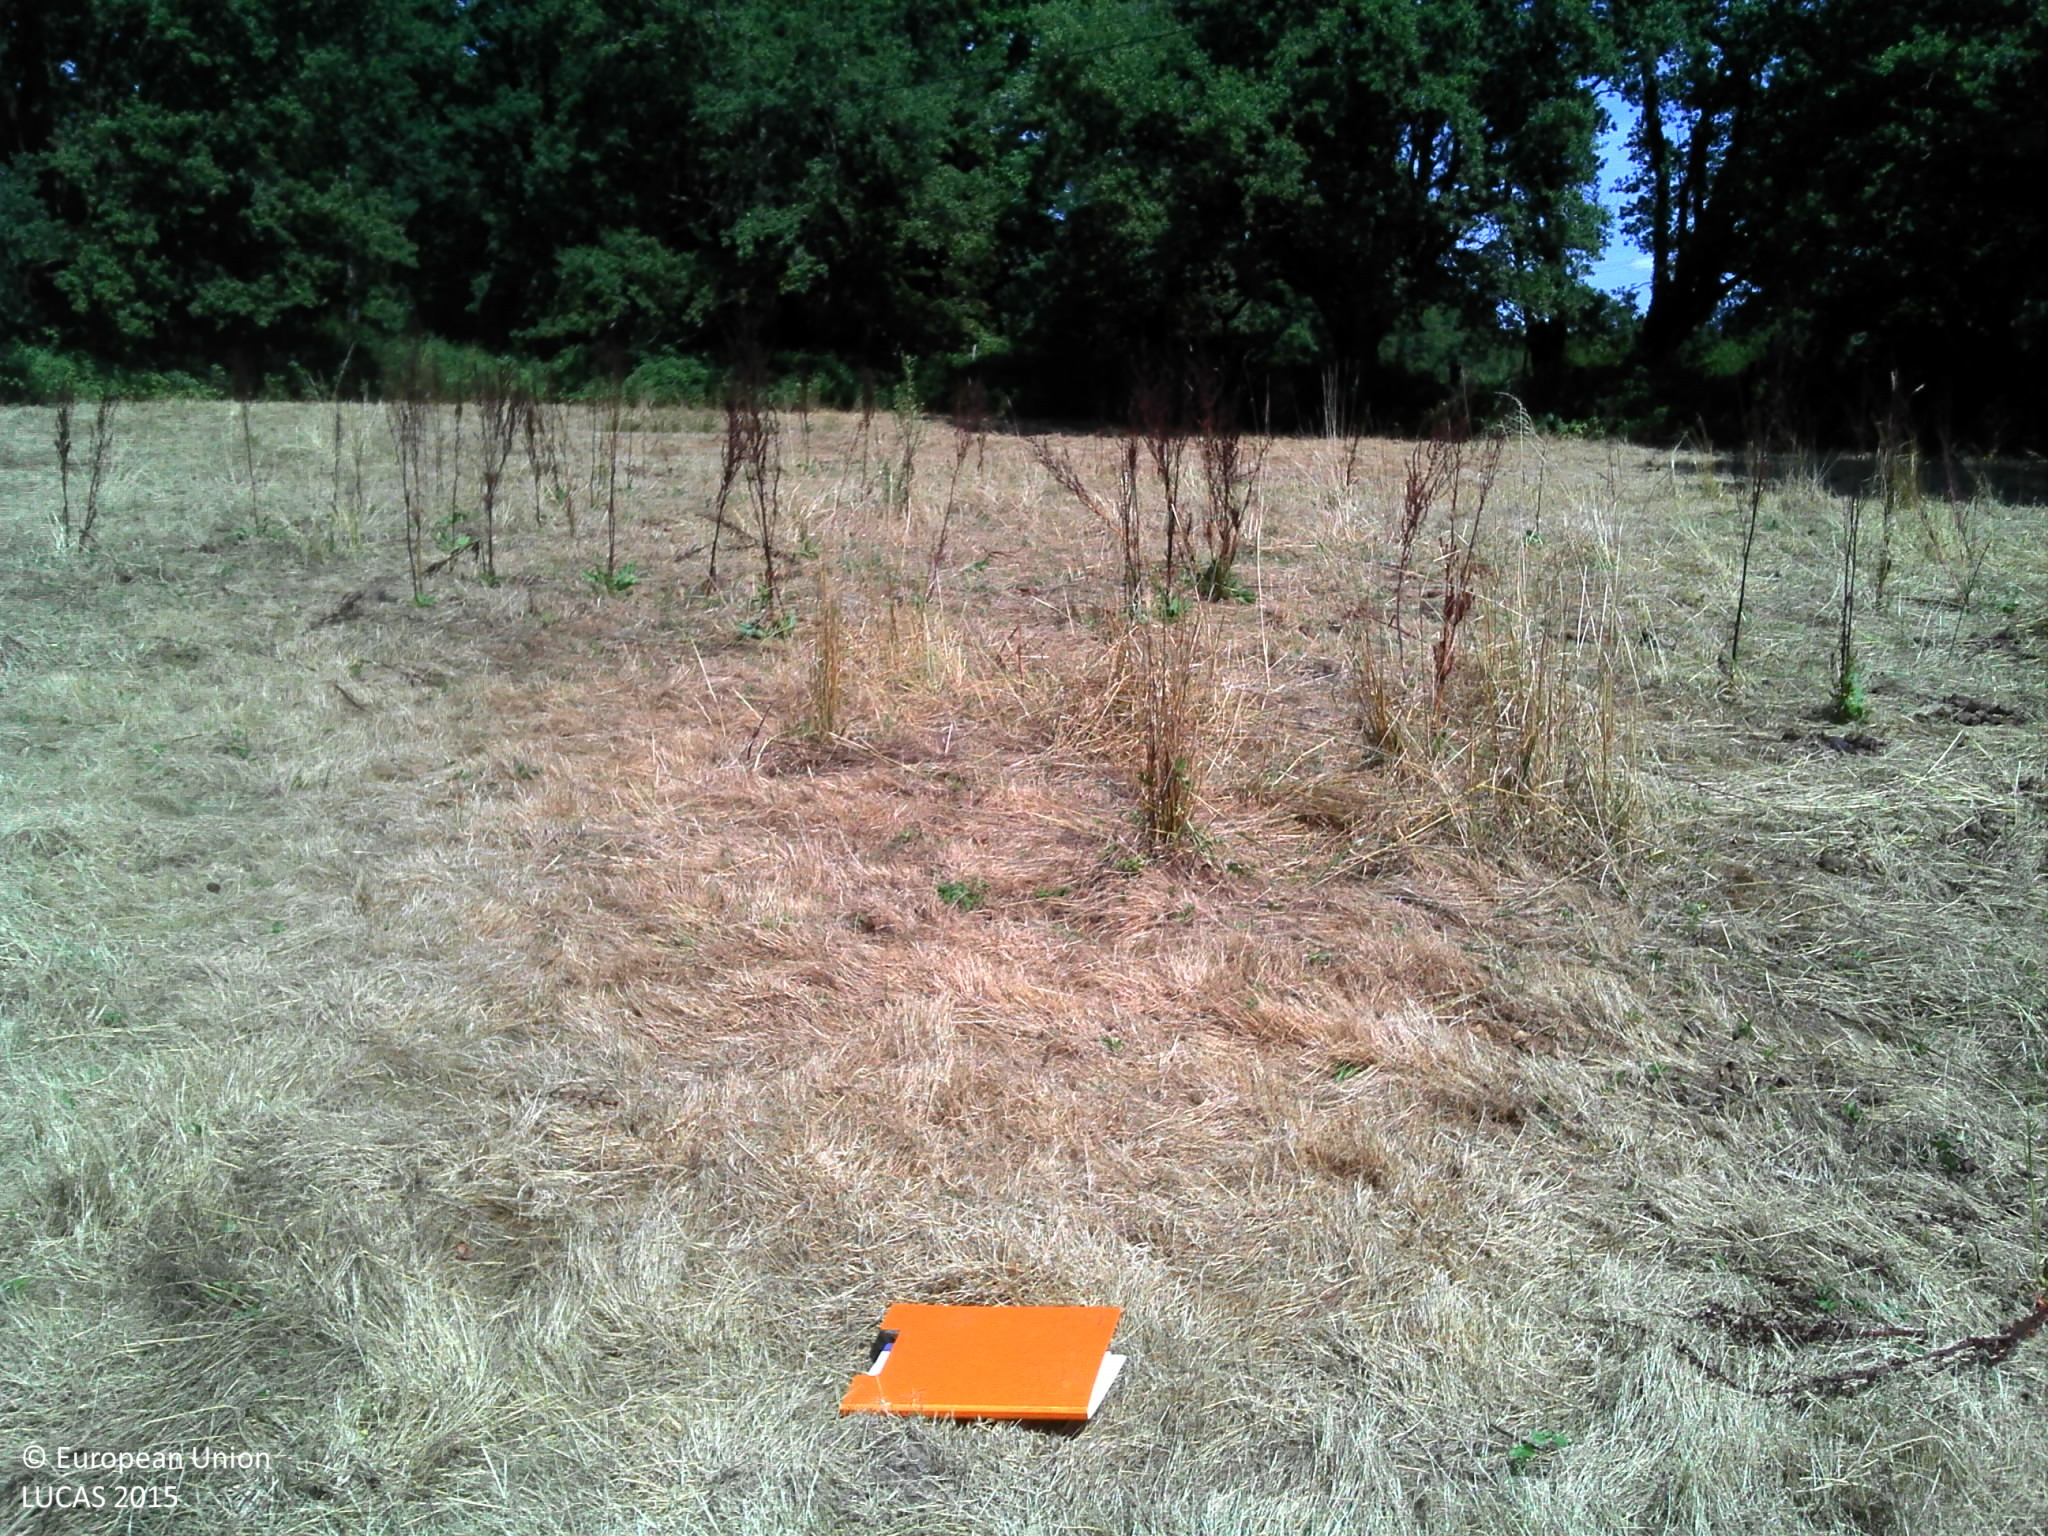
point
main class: Grassland
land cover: Grassland without tree/shrub cover
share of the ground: > 75 %
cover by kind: herbaceous plants 100 %
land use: Agriculture (excluding fallow land and kitchen gardens)
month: August
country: FR
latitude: 47.2349
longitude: 2.1049
